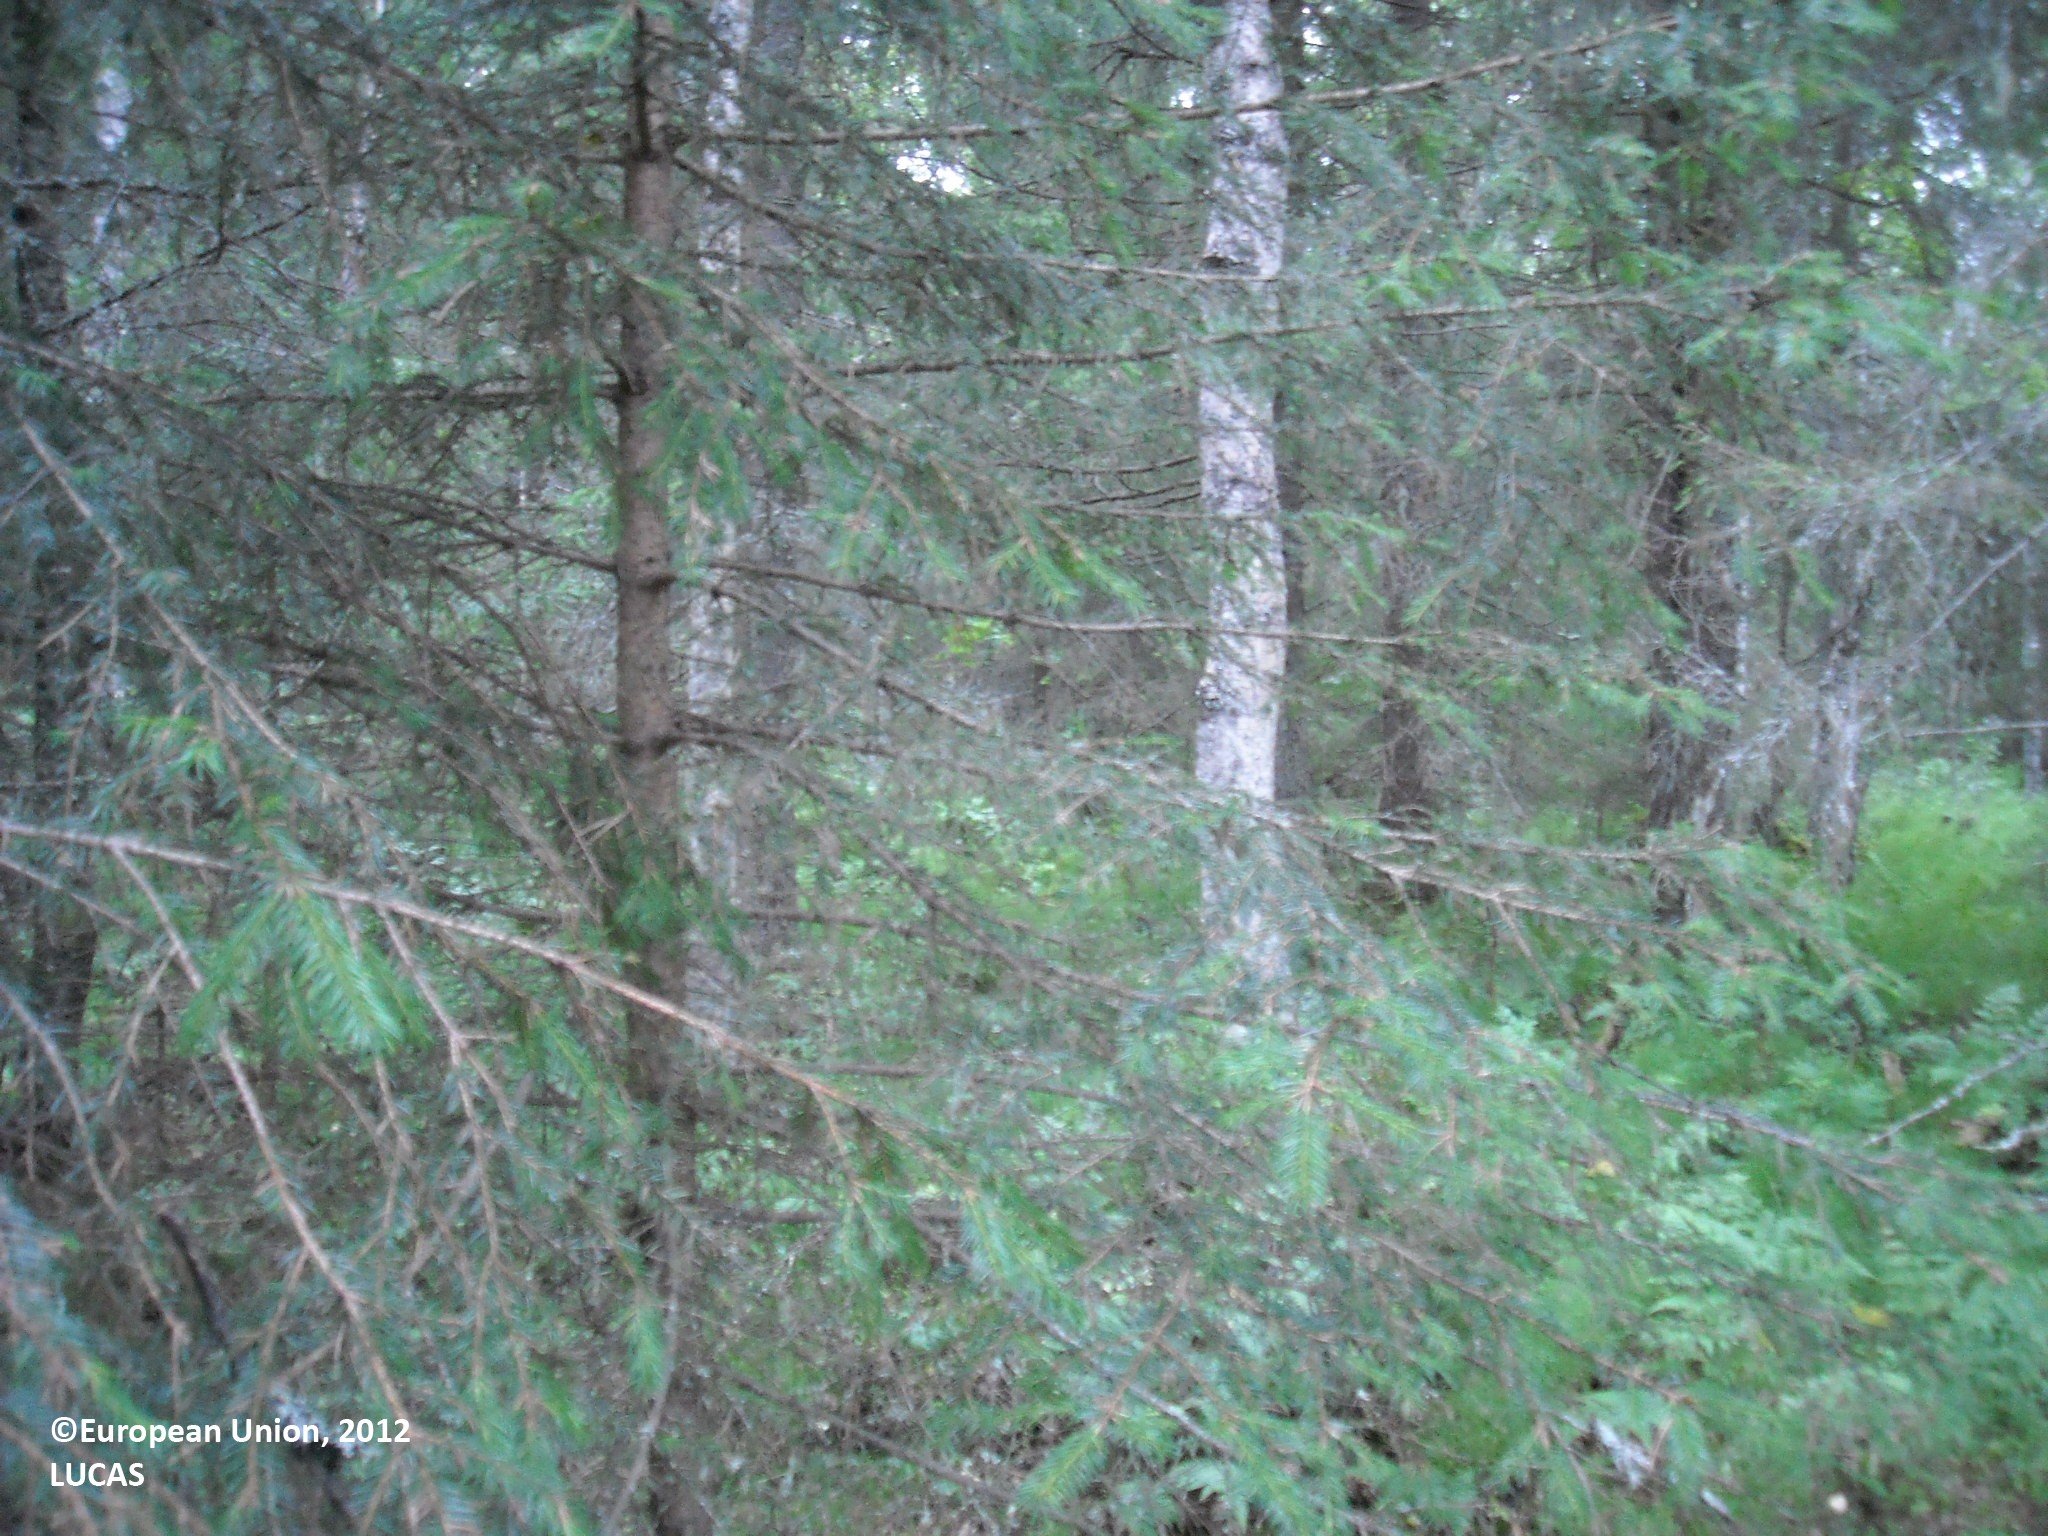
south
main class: Woodland
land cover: Other mixed woodland
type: boreal forest
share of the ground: > 75 %
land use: Forestry
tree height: > 5 m
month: July
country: FI
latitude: 64.8785
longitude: 26.6867
